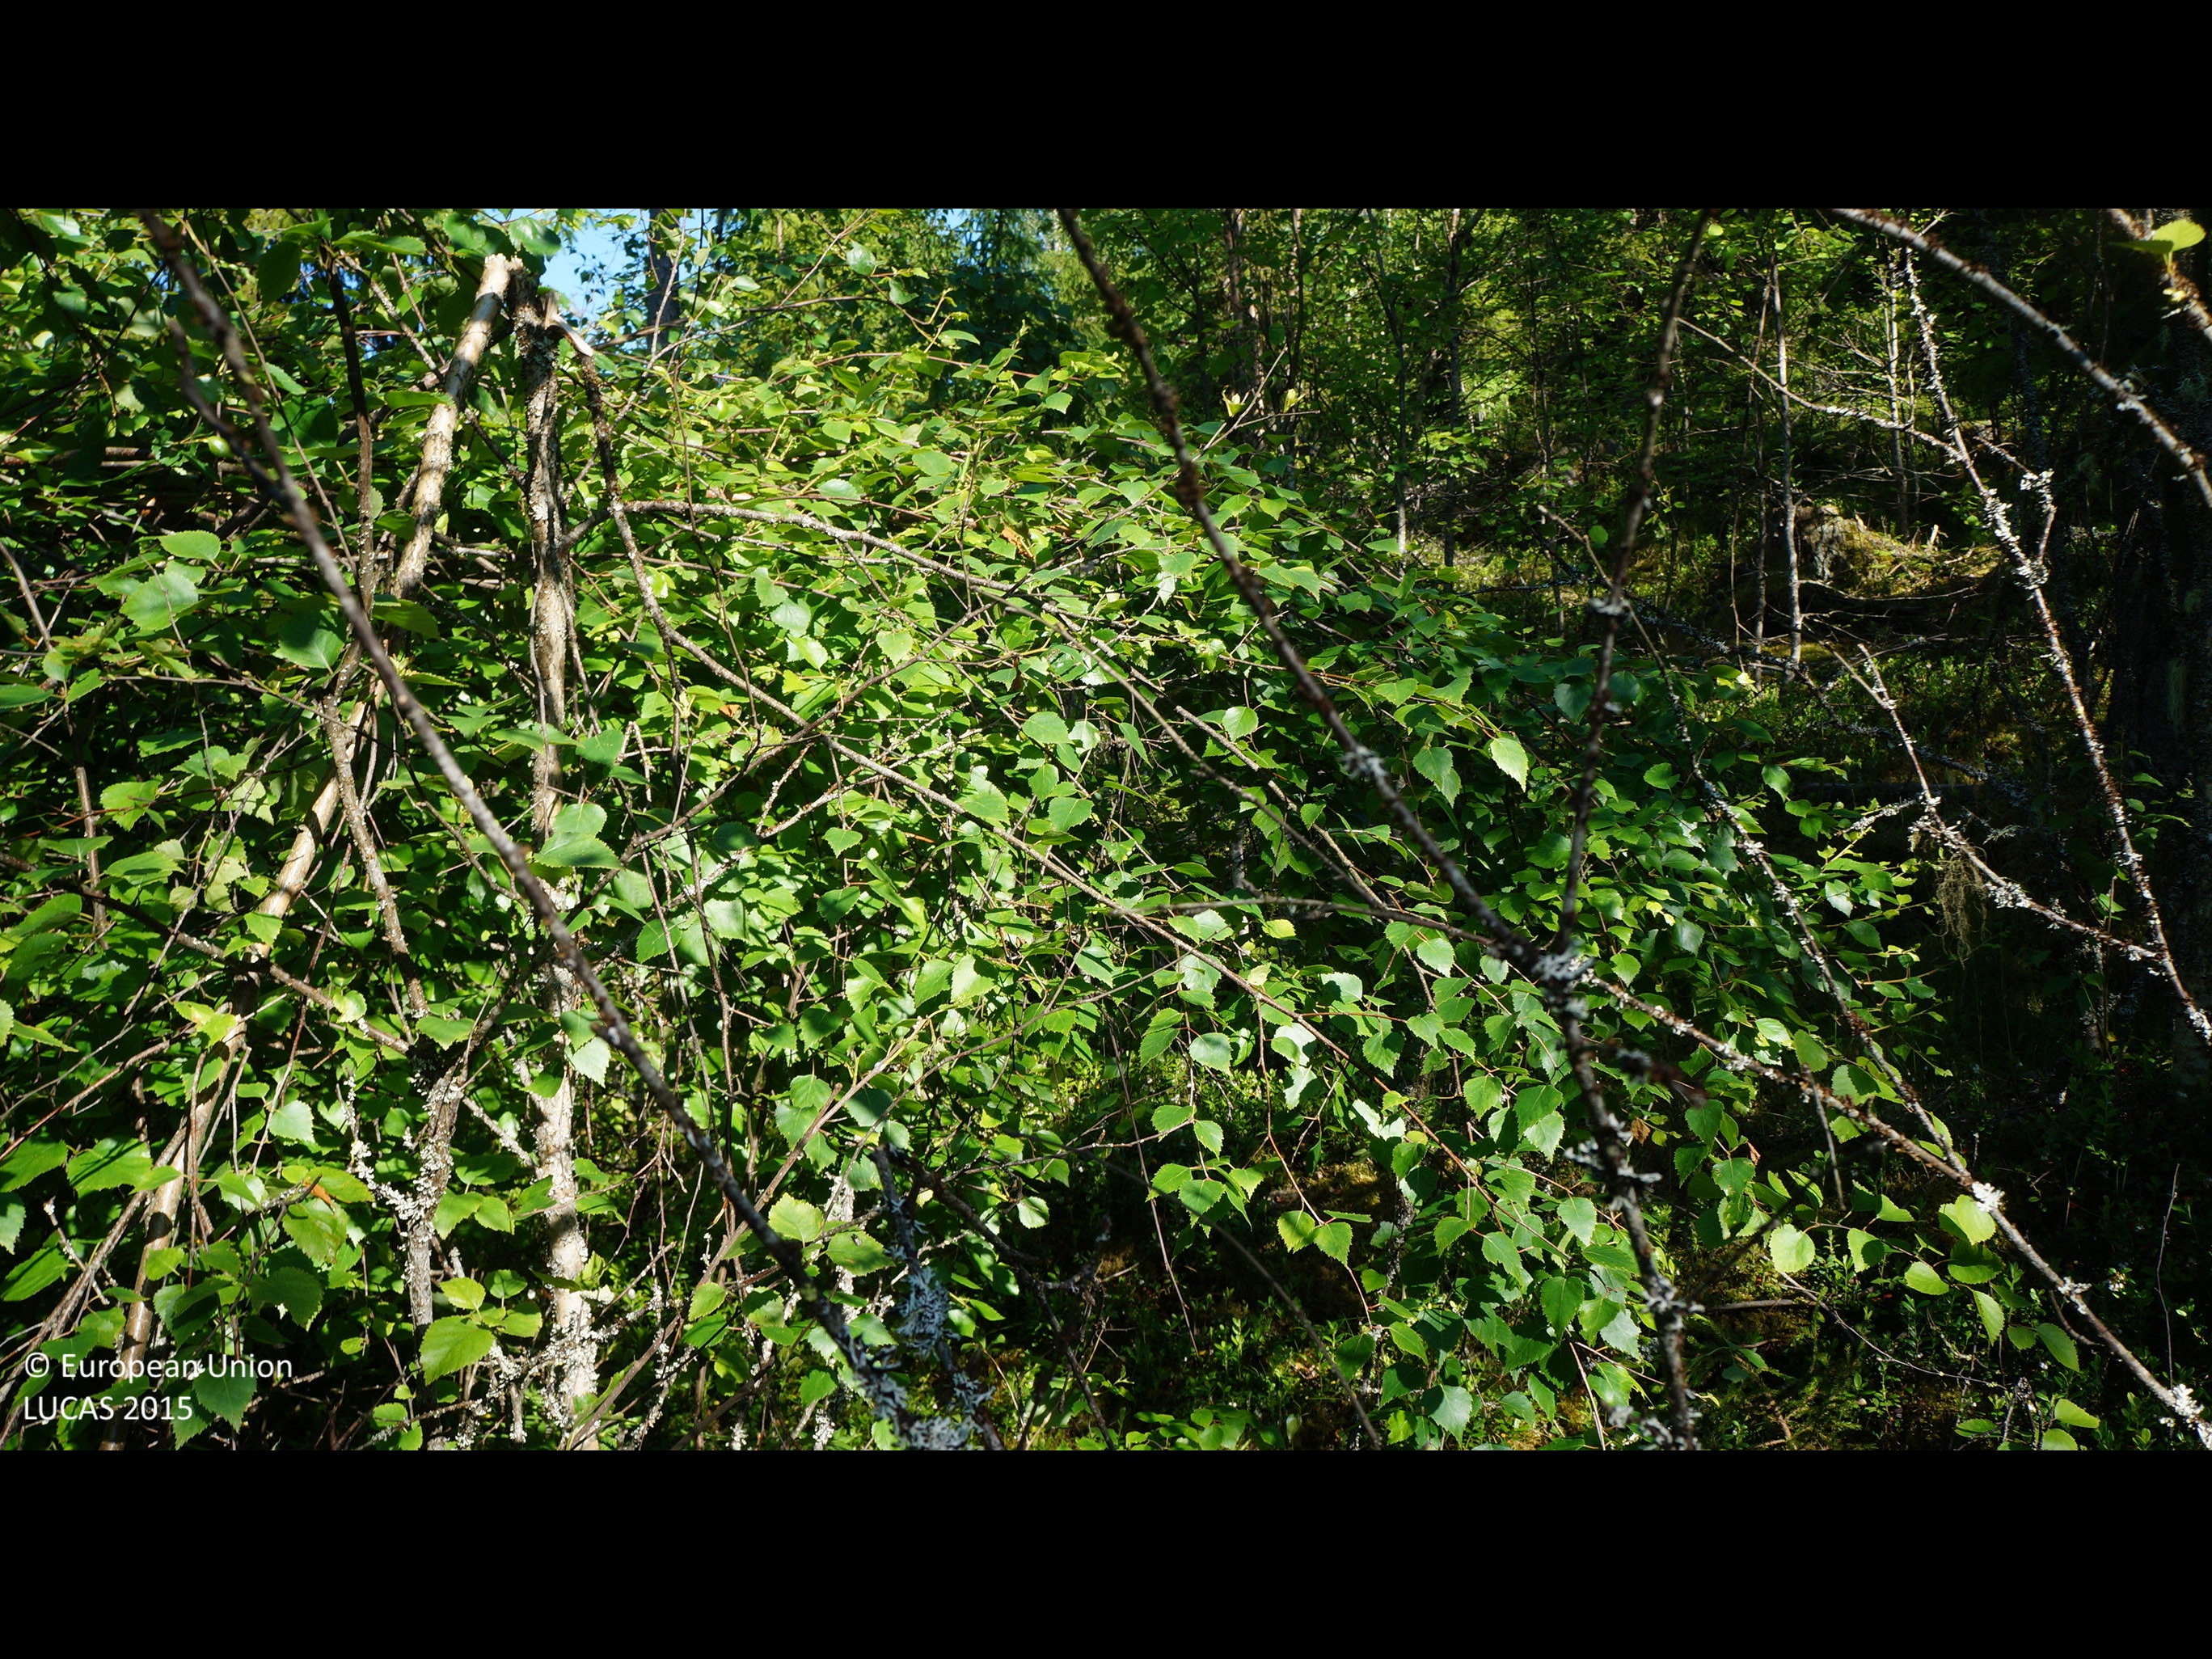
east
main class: Woodland
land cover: Broadleaved woodland
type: boreal forest
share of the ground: 50 - 75 %
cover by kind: broadleaved forest trees 50 %, shrubs 45 %, coniferous forest trees 5 %
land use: Forestry
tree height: > 5 m
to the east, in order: Broadleaved woodland; Rivers and streams; Broadleaved woodland; Other mixed woodland
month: July
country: FI
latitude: 63.6942
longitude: 23.0170
